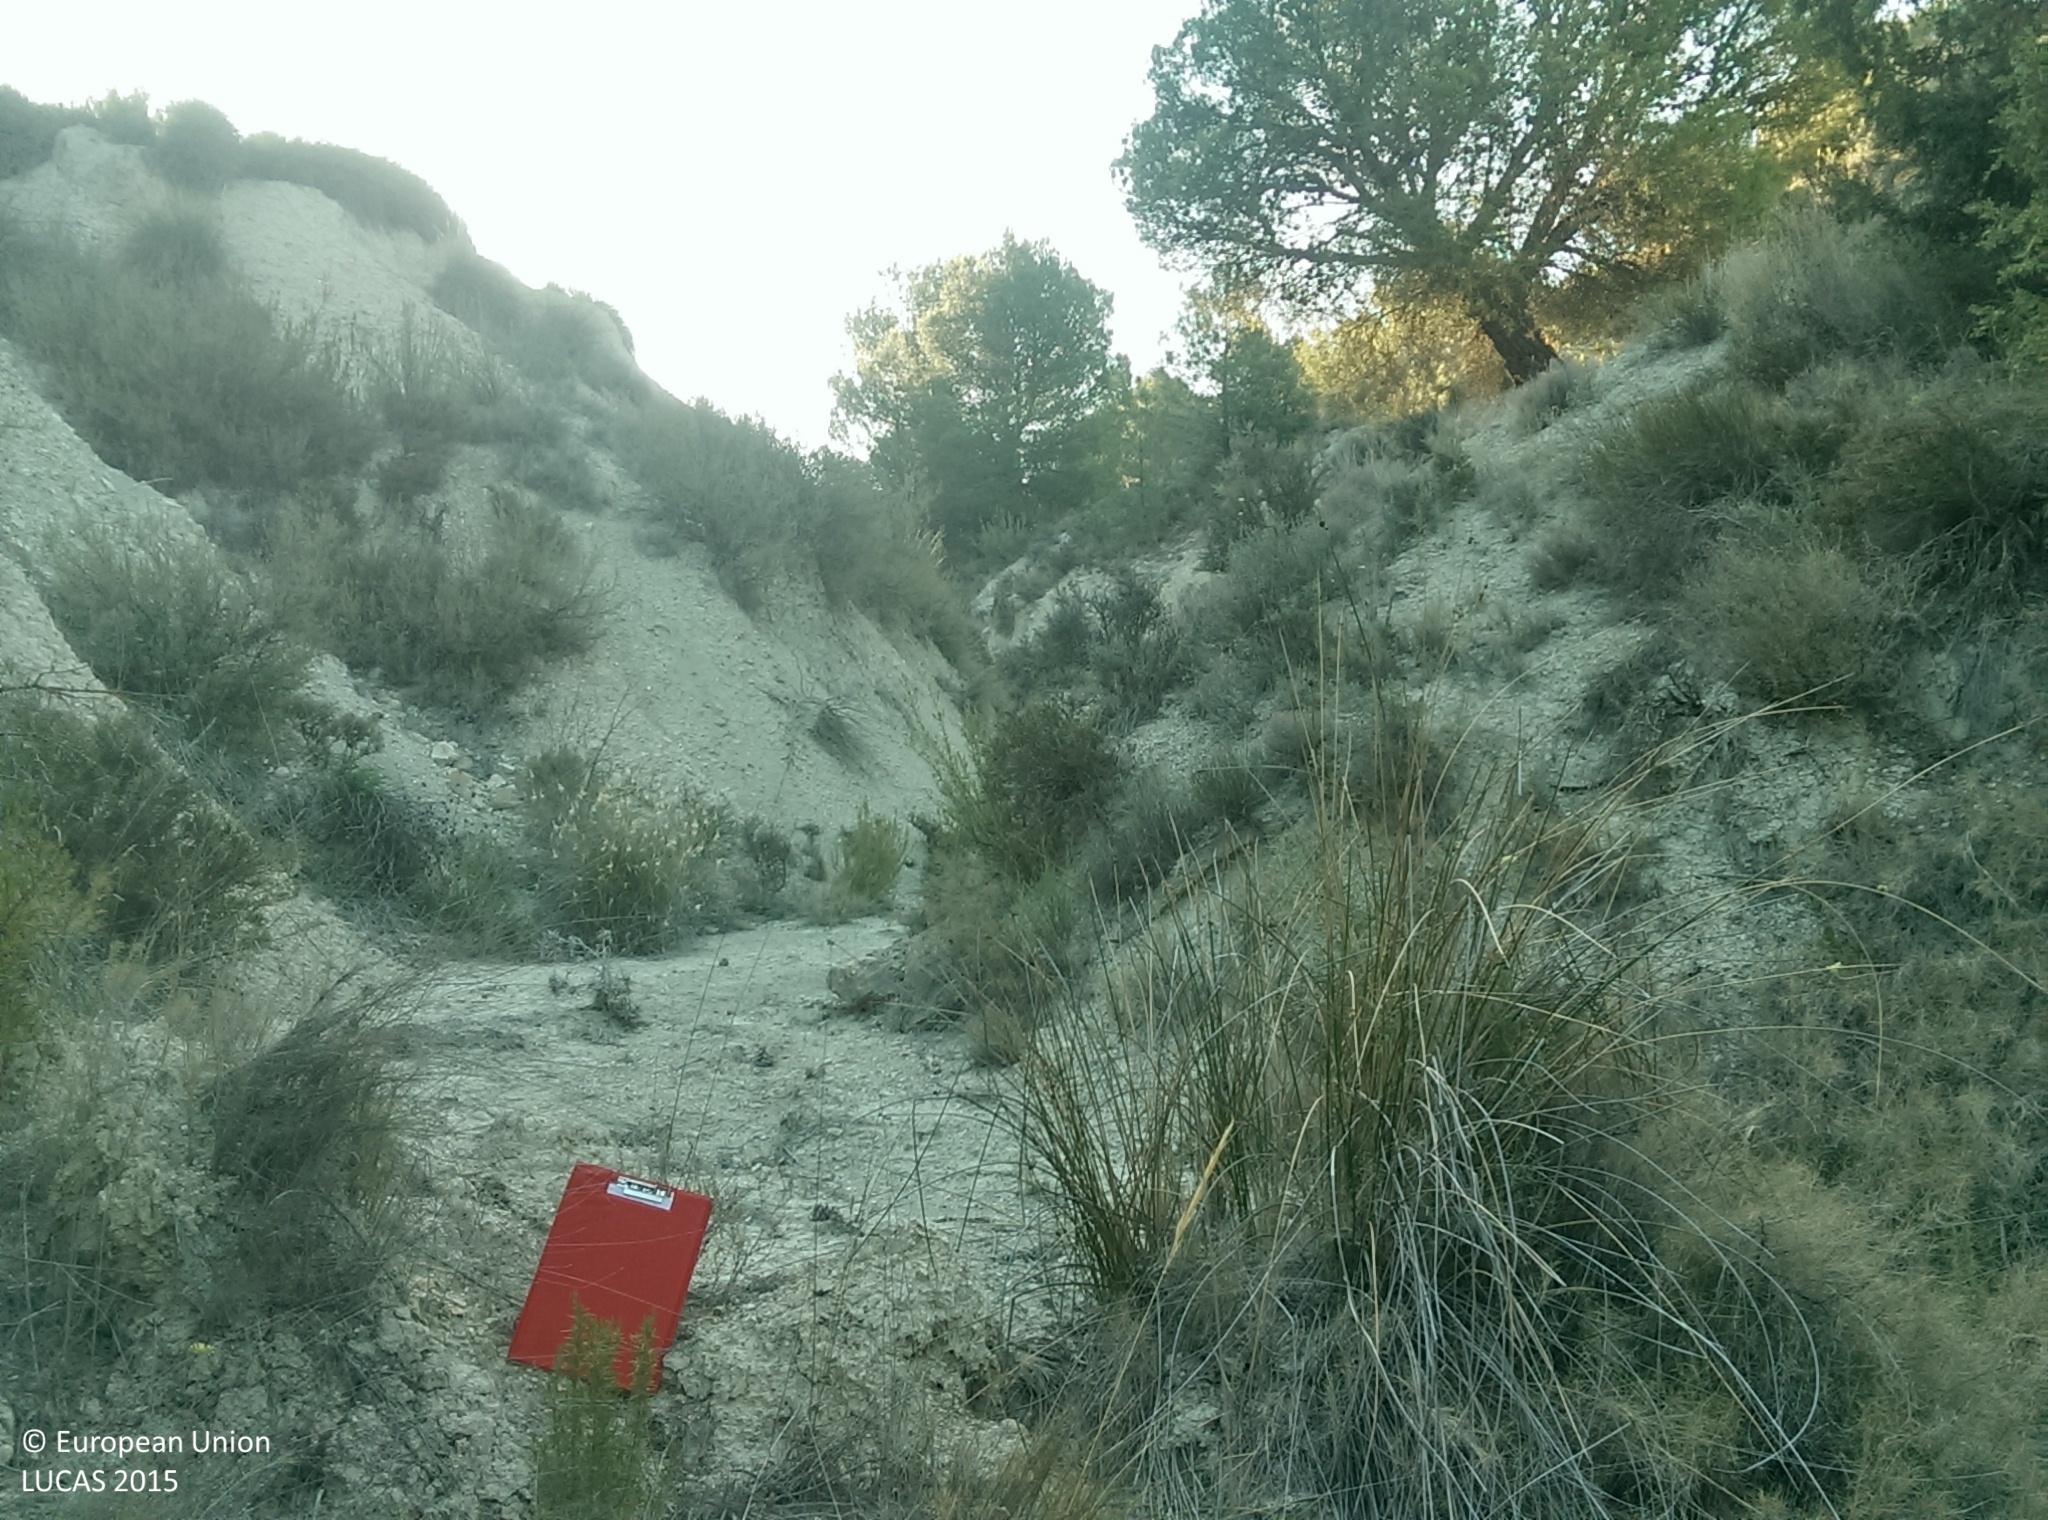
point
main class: Shrubland
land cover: Shrubland without tree cover
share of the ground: 25 - 50 %
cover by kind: herbaceous plants 60 %, shrubs 30 %, unconsolidated bare surface 10 %
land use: Forestry
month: June
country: ES
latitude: 37.5954
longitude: -3.1868
